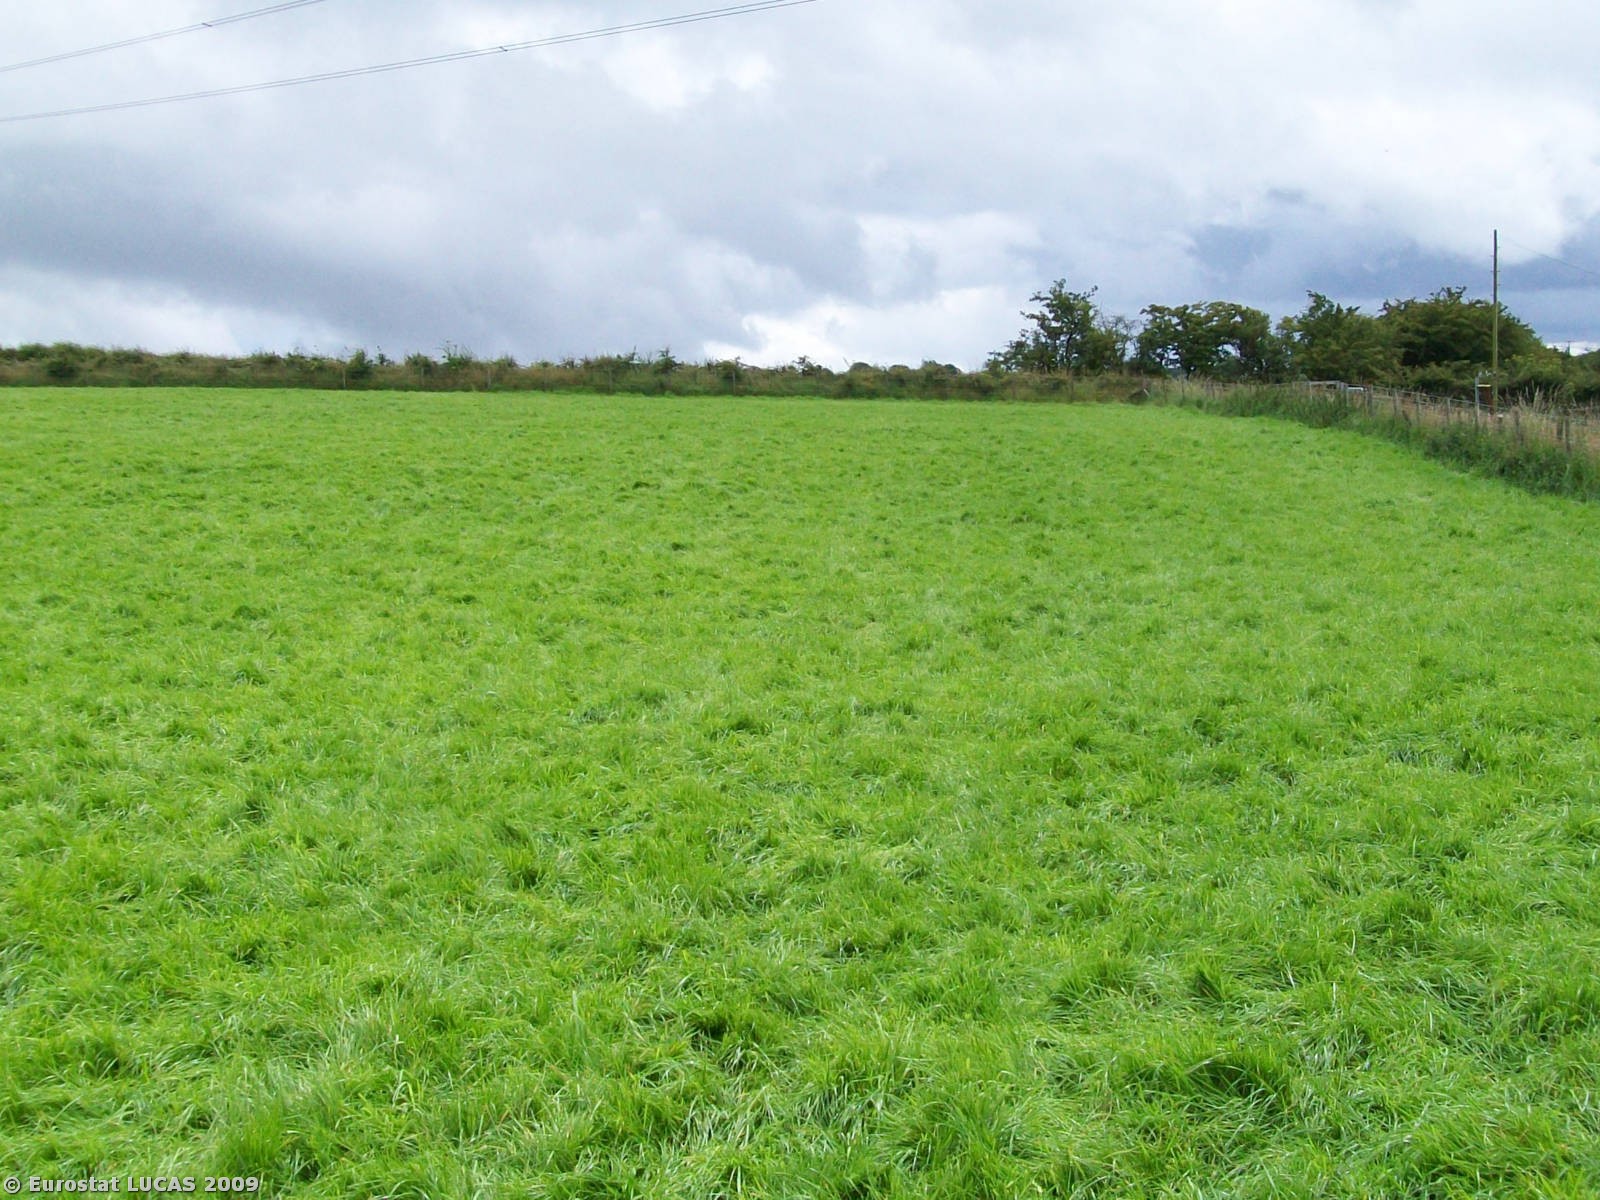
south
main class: Grassland
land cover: Grassland without tree/shrub cover
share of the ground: > 75 %
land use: Agriculture (excluding fallow land and kitchen gardens)
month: July
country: GB
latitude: 54.7707
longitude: -5.8514
